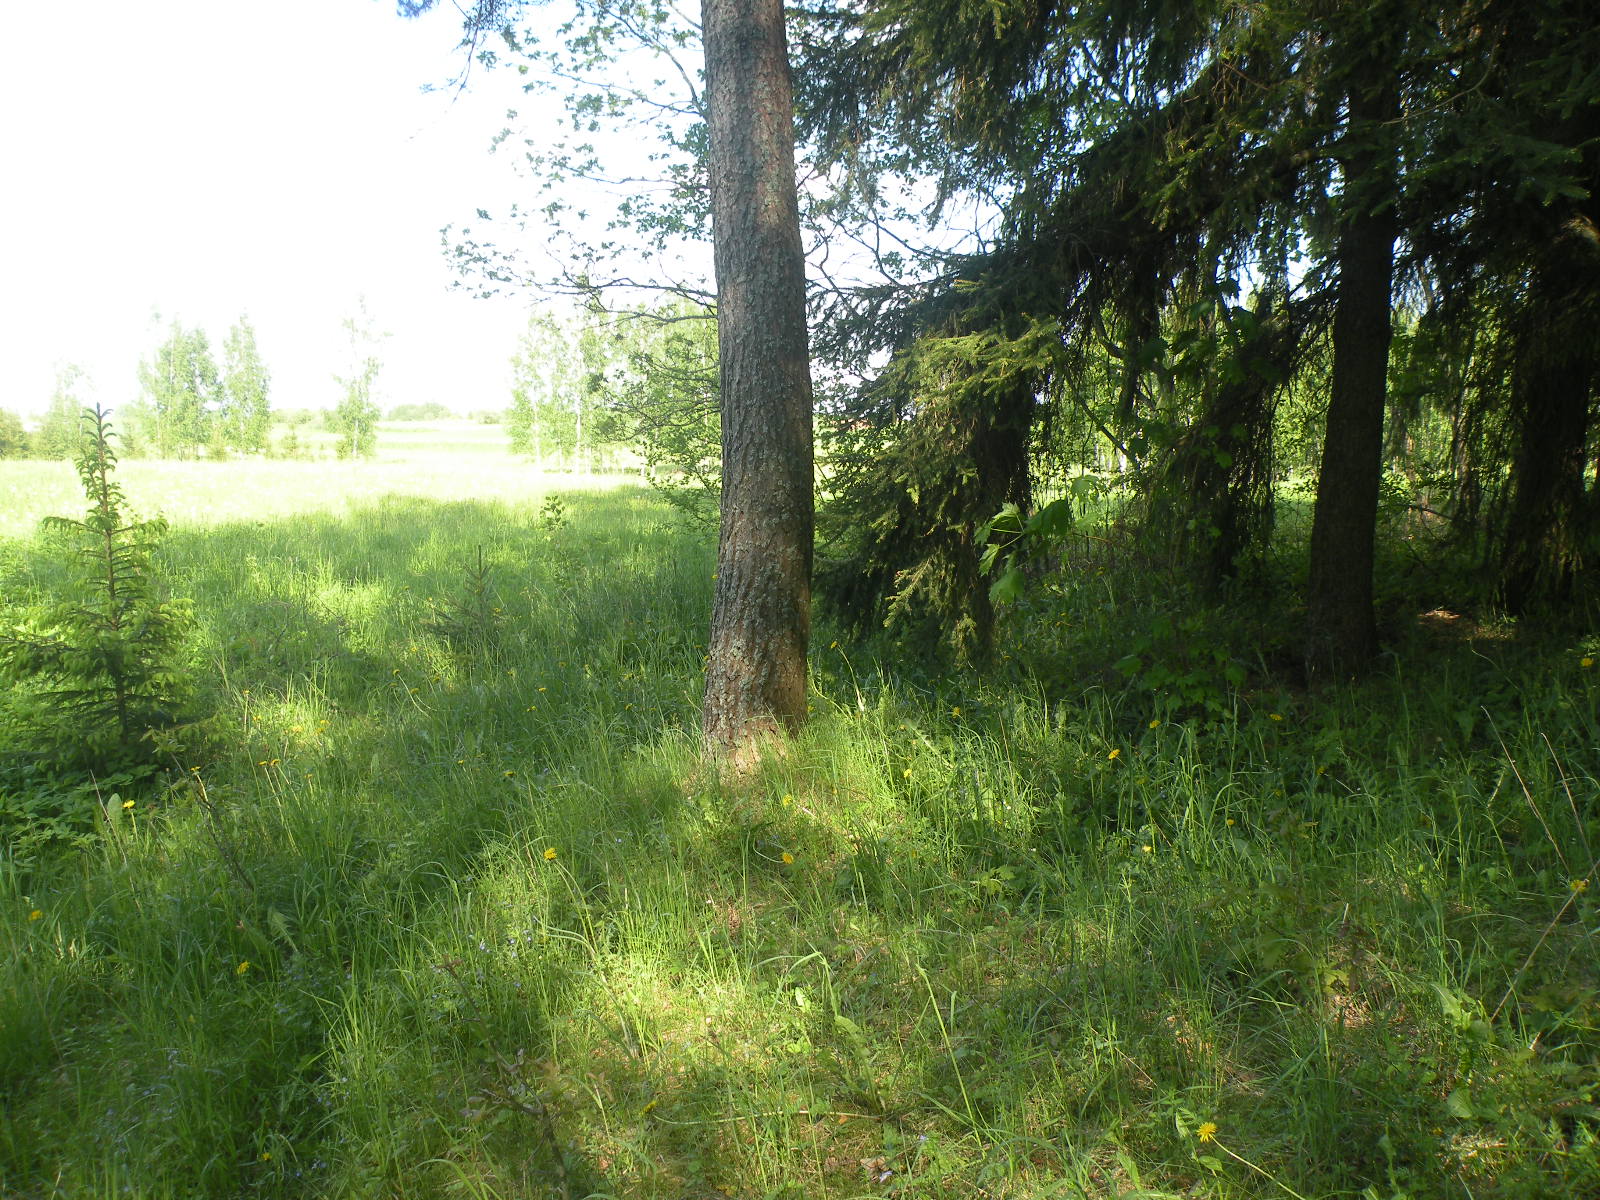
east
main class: Woodland
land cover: Broadleaved woodland
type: non-riverine alder, birch or aspen forest
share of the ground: > 75 %
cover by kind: broadleaved forest trees 75 %, herbaceous plants 25 %
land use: Forestry
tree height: > 5 m
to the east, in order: Broadleaved woodland; Spruce dominated mixed woodland; Grassland without tree/shrub cover; Broadleaved woodland; Grassland without tree/shrub cover; Broadleaved woodland; Grassland without tree/shrub cover; Electric lines; Grassland without tree/shrub cover
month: May
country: LV
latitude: 55.9841
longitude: 25.9874
